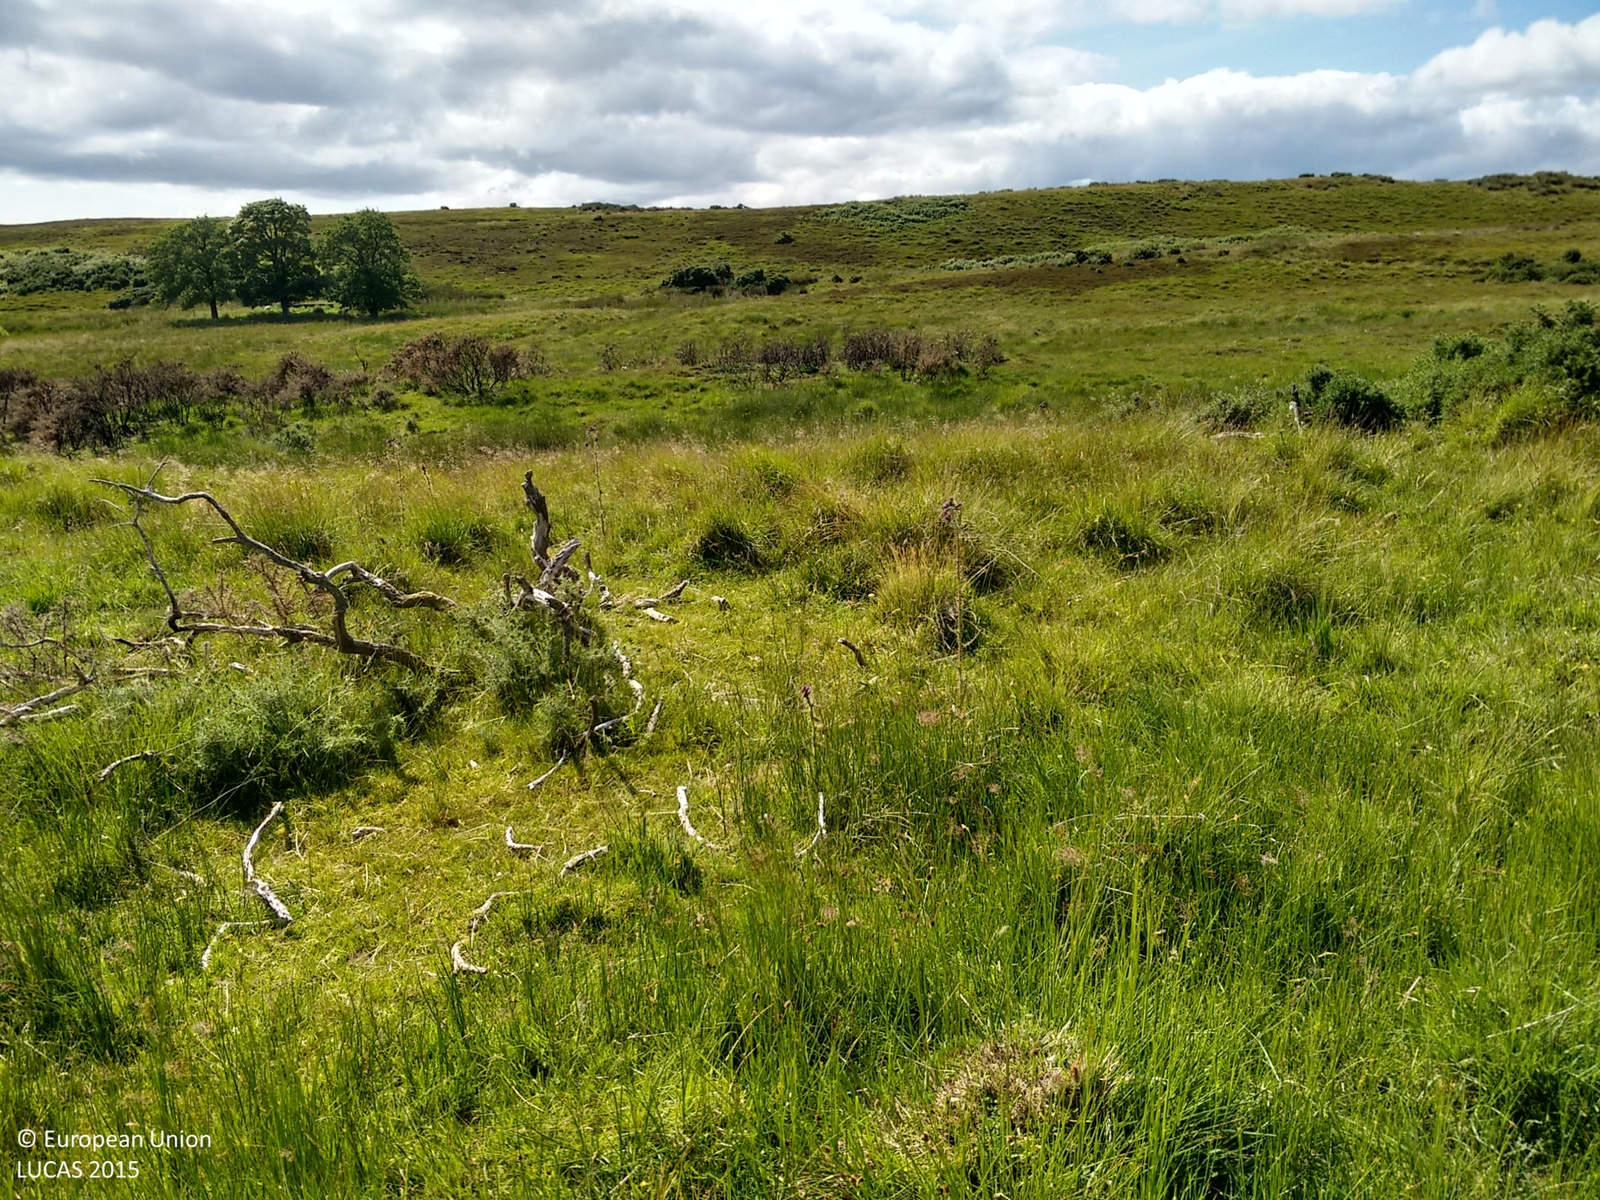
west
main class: Grassland
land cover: Grassland without tree/shrub cover
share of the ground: > 75 %
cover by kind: herbaceous plants 70 %, lichens and mosses 30 %
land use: Agriculture (excluding fallow land and kitchen gardens)
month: July
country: GB
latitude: 55.7871
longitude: -5.0544
